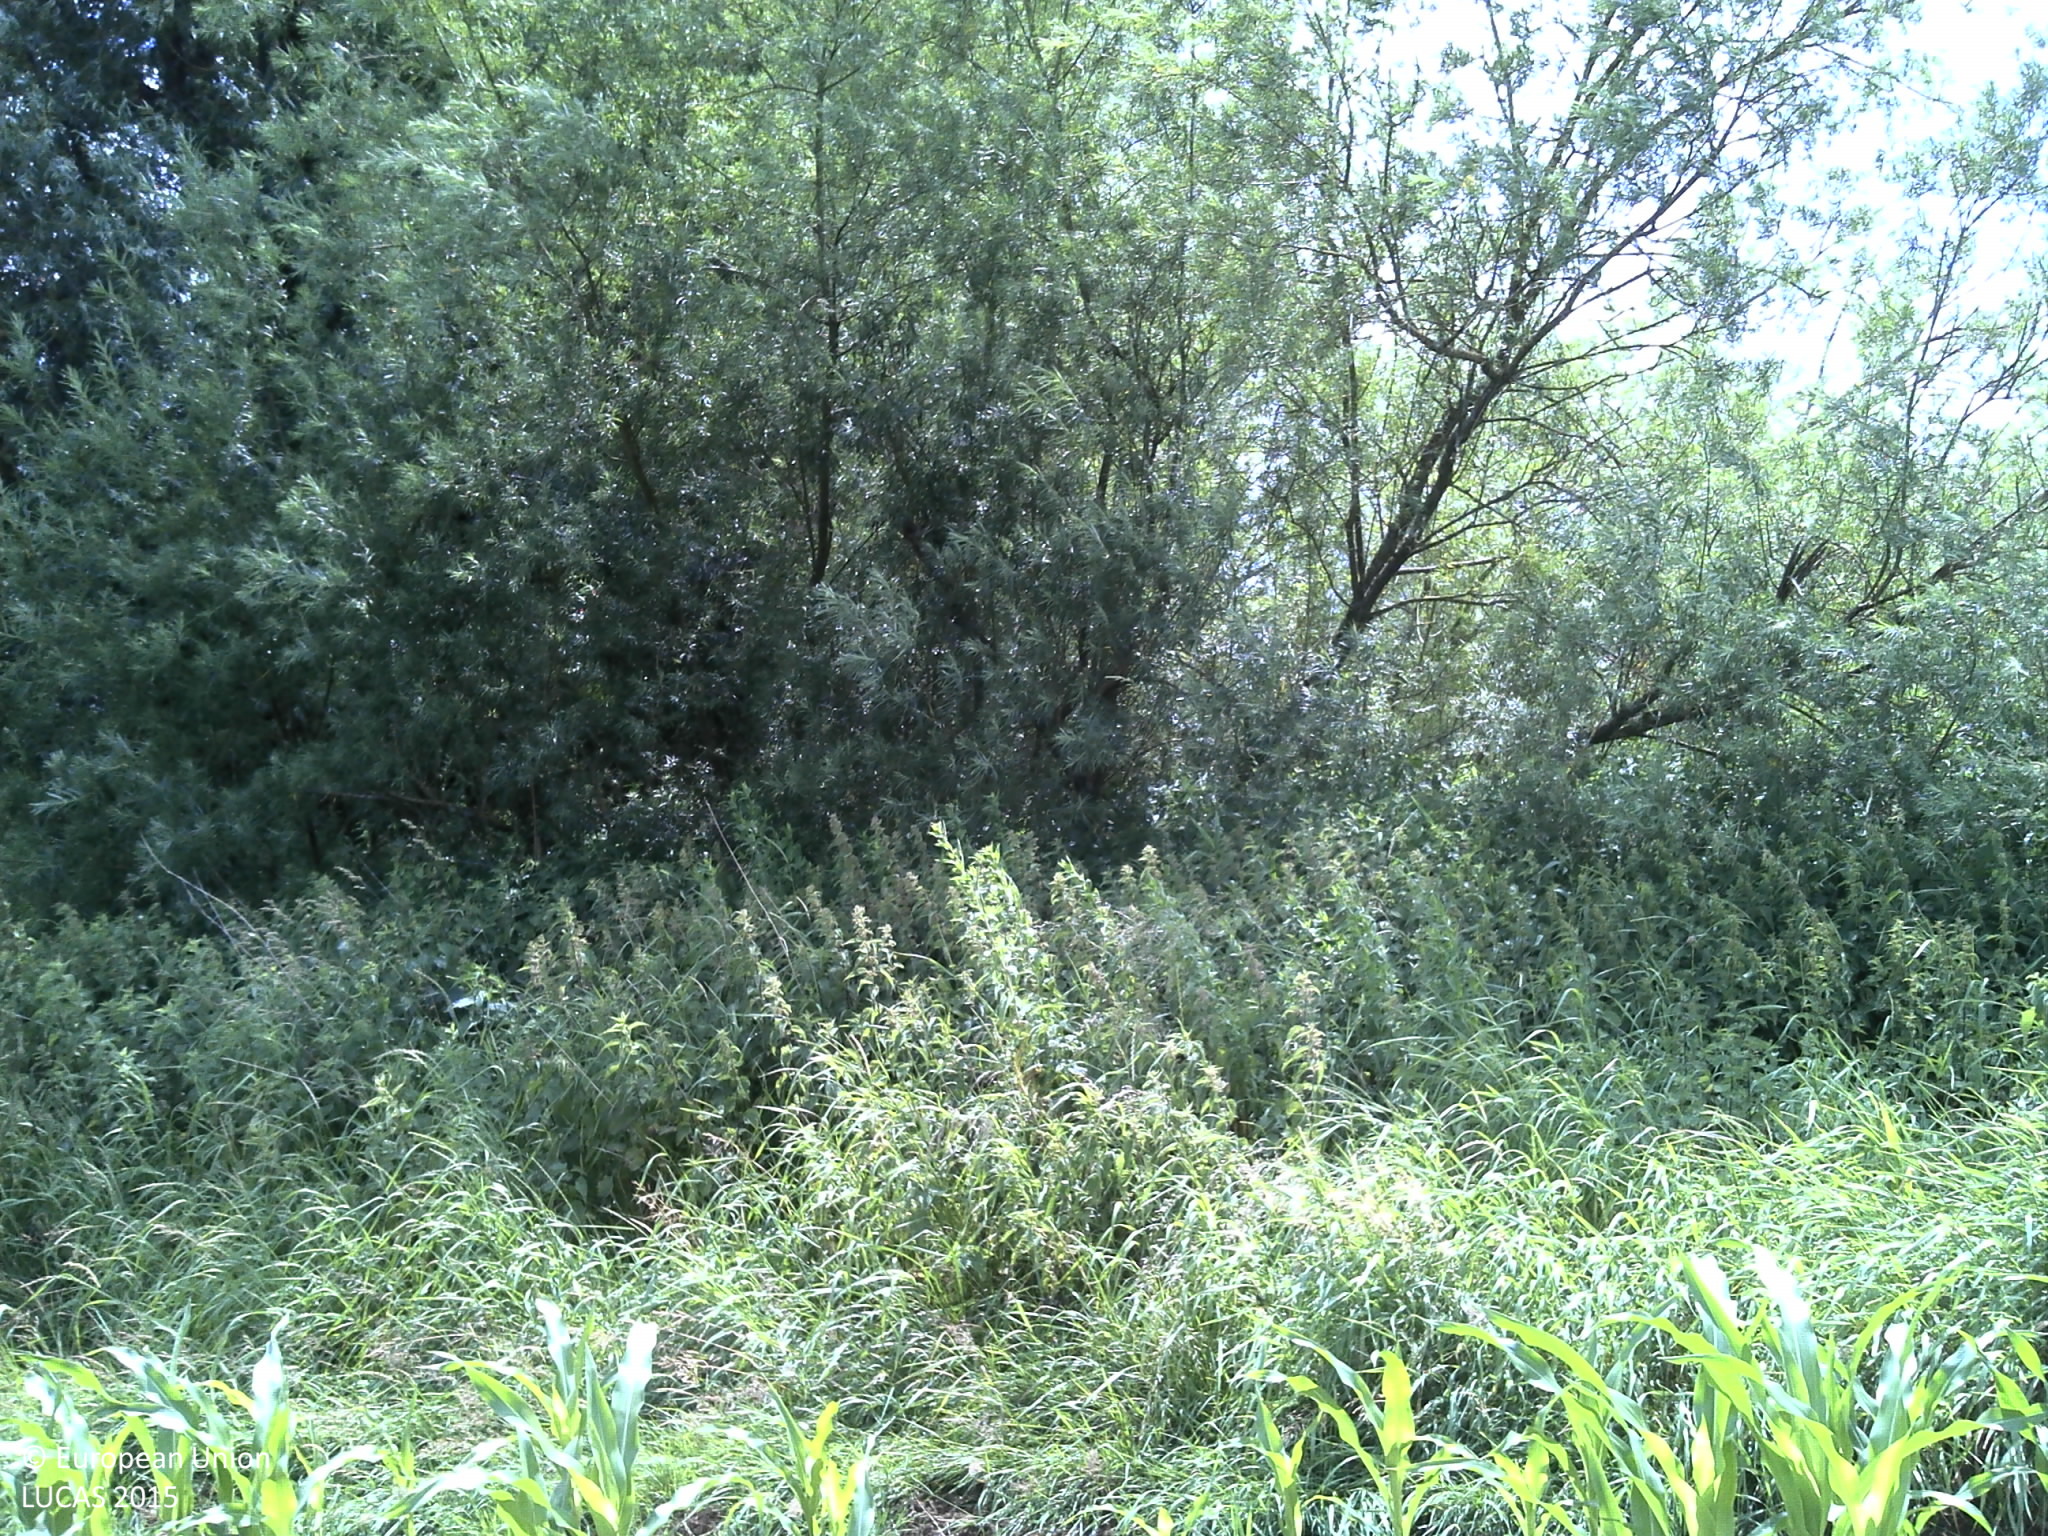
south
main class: Cropland
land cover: Maize
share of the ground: 50 - 75 %
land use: Agriculture (excluding fallow land and kitchen gardens)
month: June
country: FR
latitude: 49.6600
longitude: 4.9964
